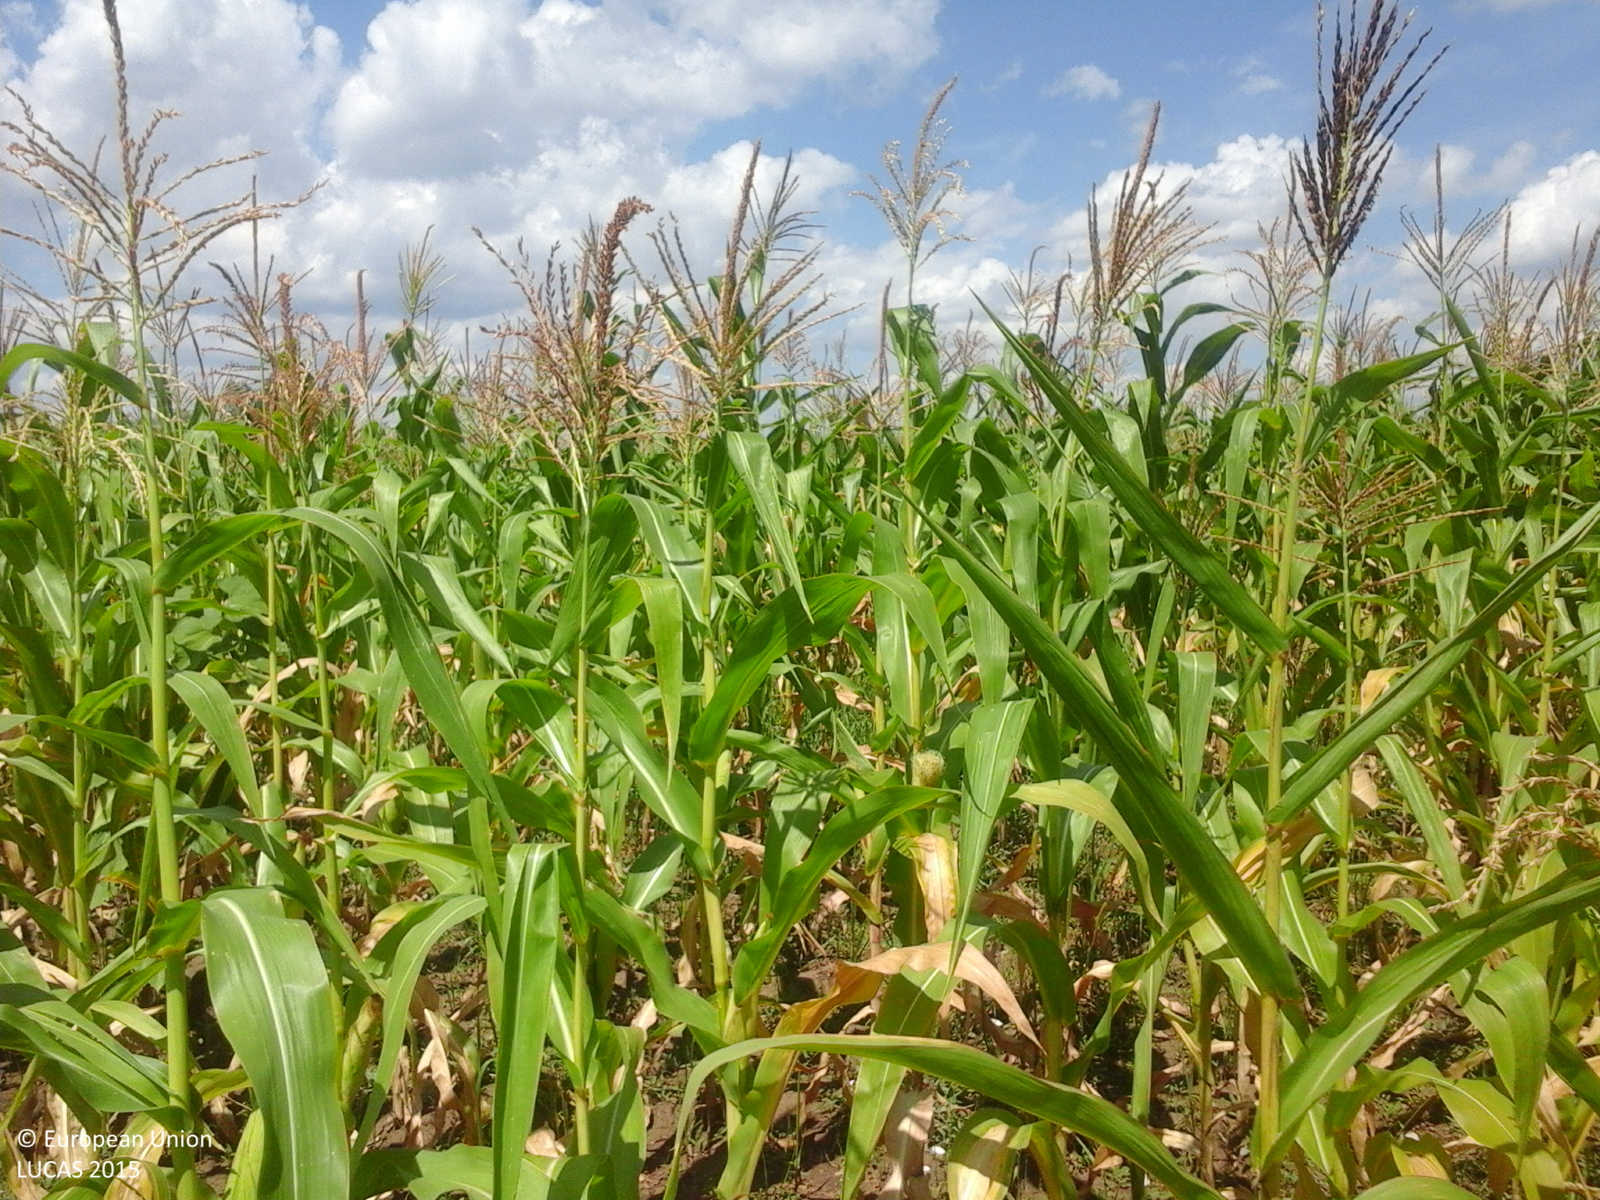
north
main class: Cropland
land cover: Maize
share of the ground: > 75 %
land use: Agriculture (excluding fallow land and kitchen gardens)
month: July
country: RO
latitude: 46.5095
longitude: 27.8592
